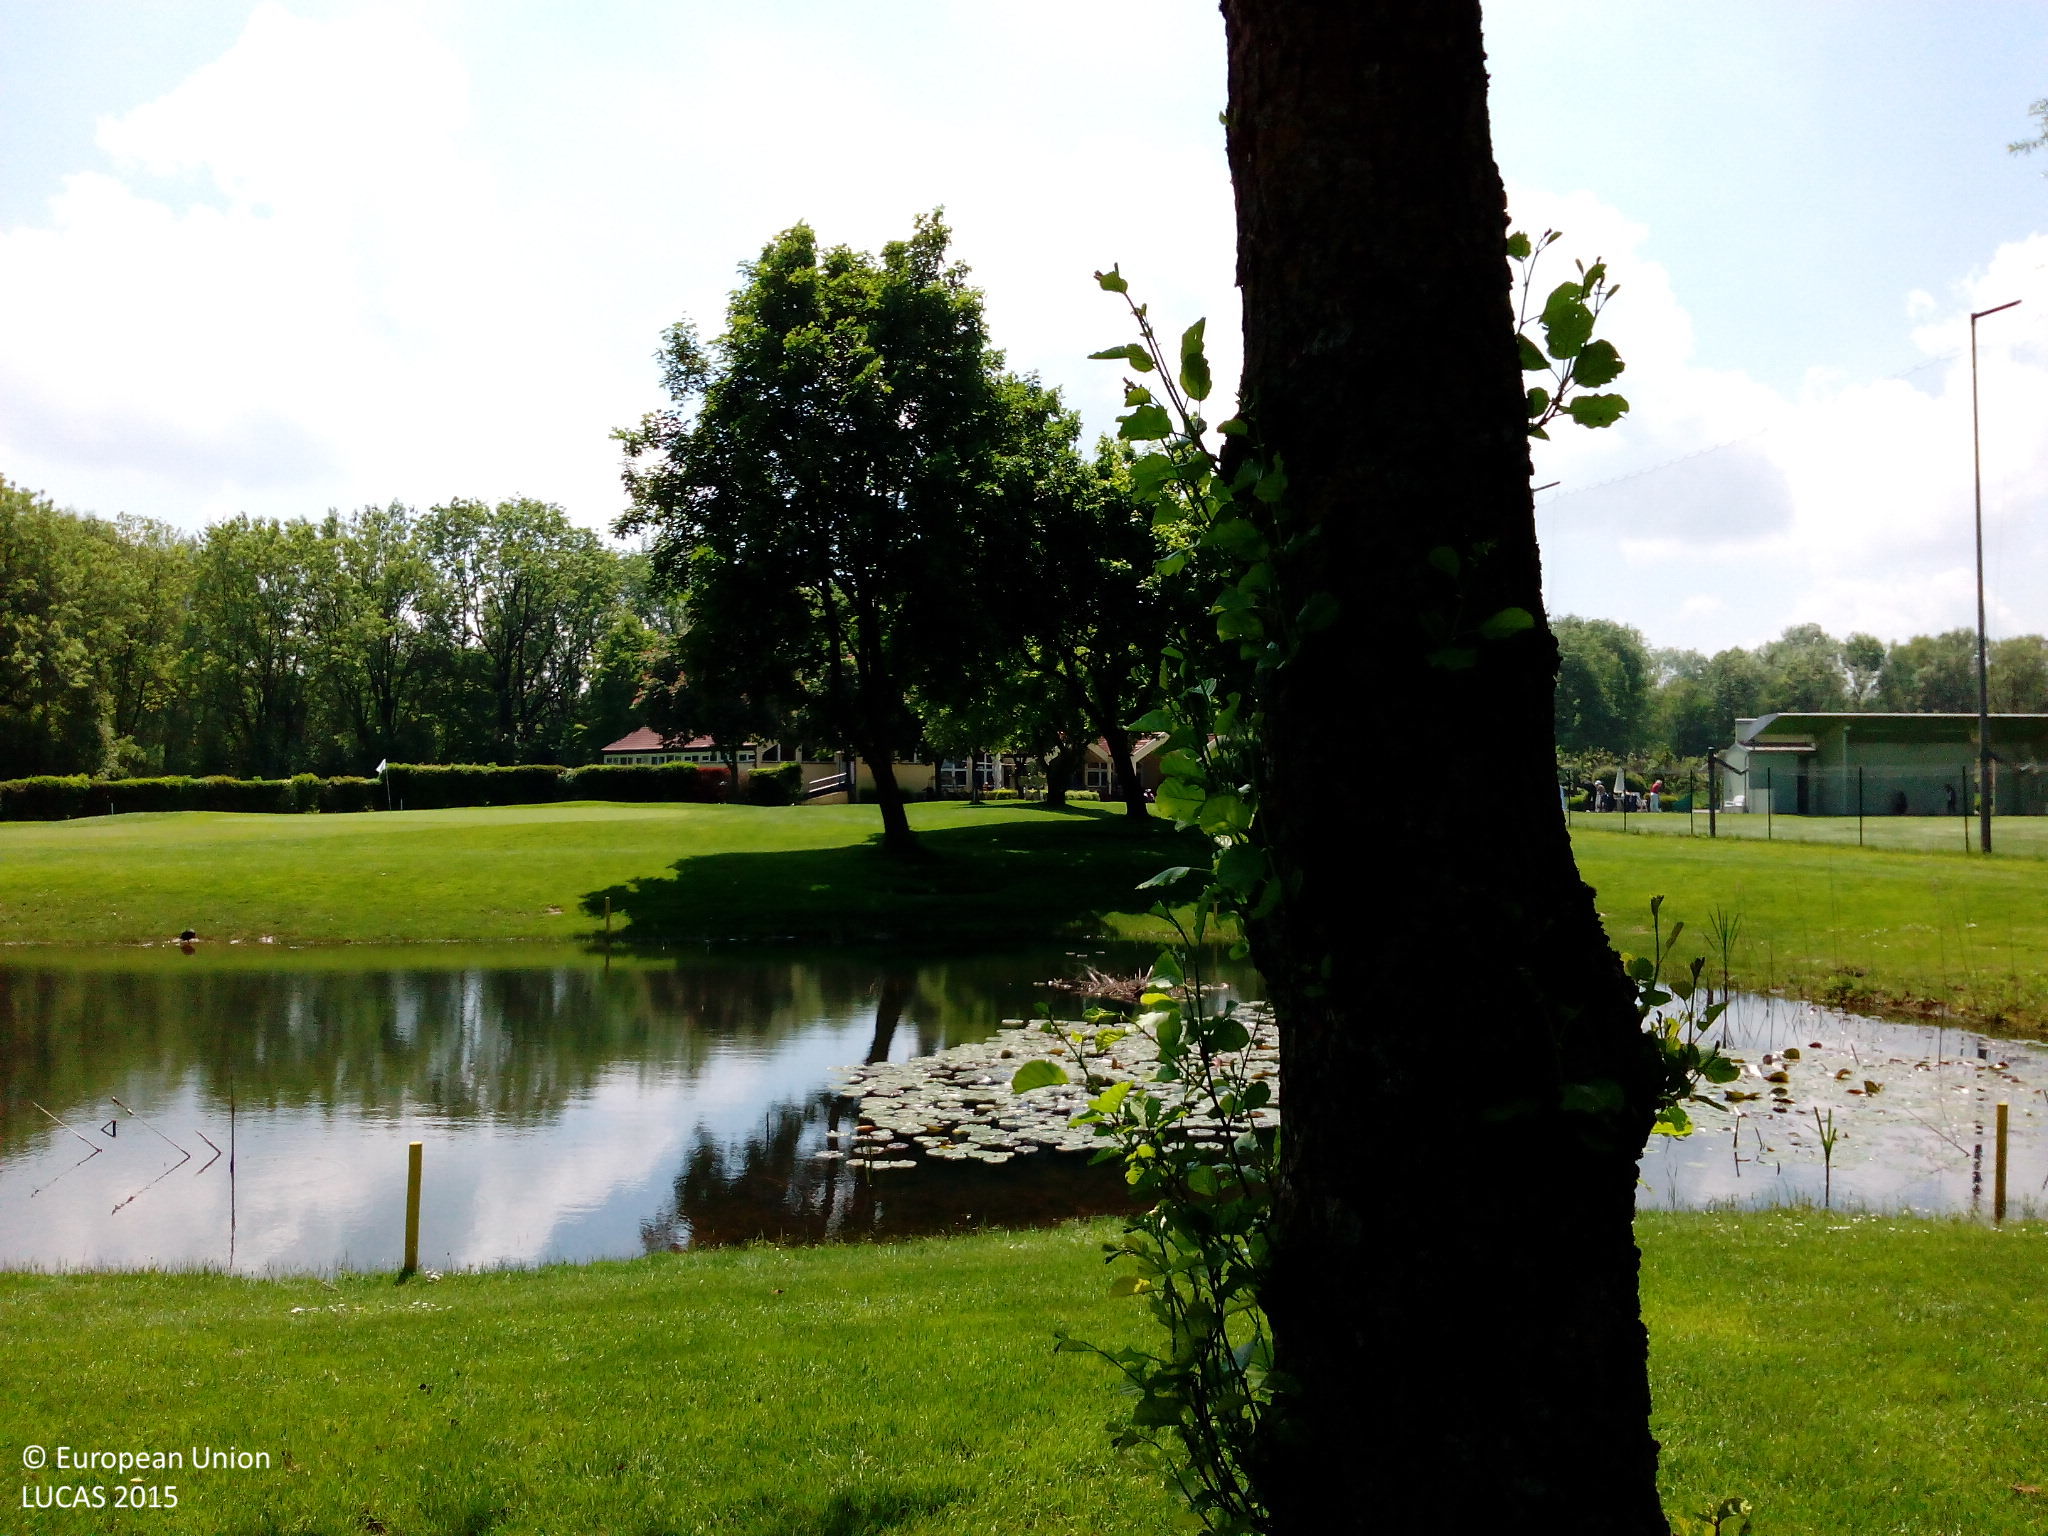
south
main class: Woodland
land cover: Broadleaved woodland
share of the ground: > 75 %
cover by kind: broadleaved forest trees 90 %, herbaceous plants 10 %
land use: Sport
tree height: > 5 m
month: May
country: DE
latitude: 48.2145
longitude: 11.4123
